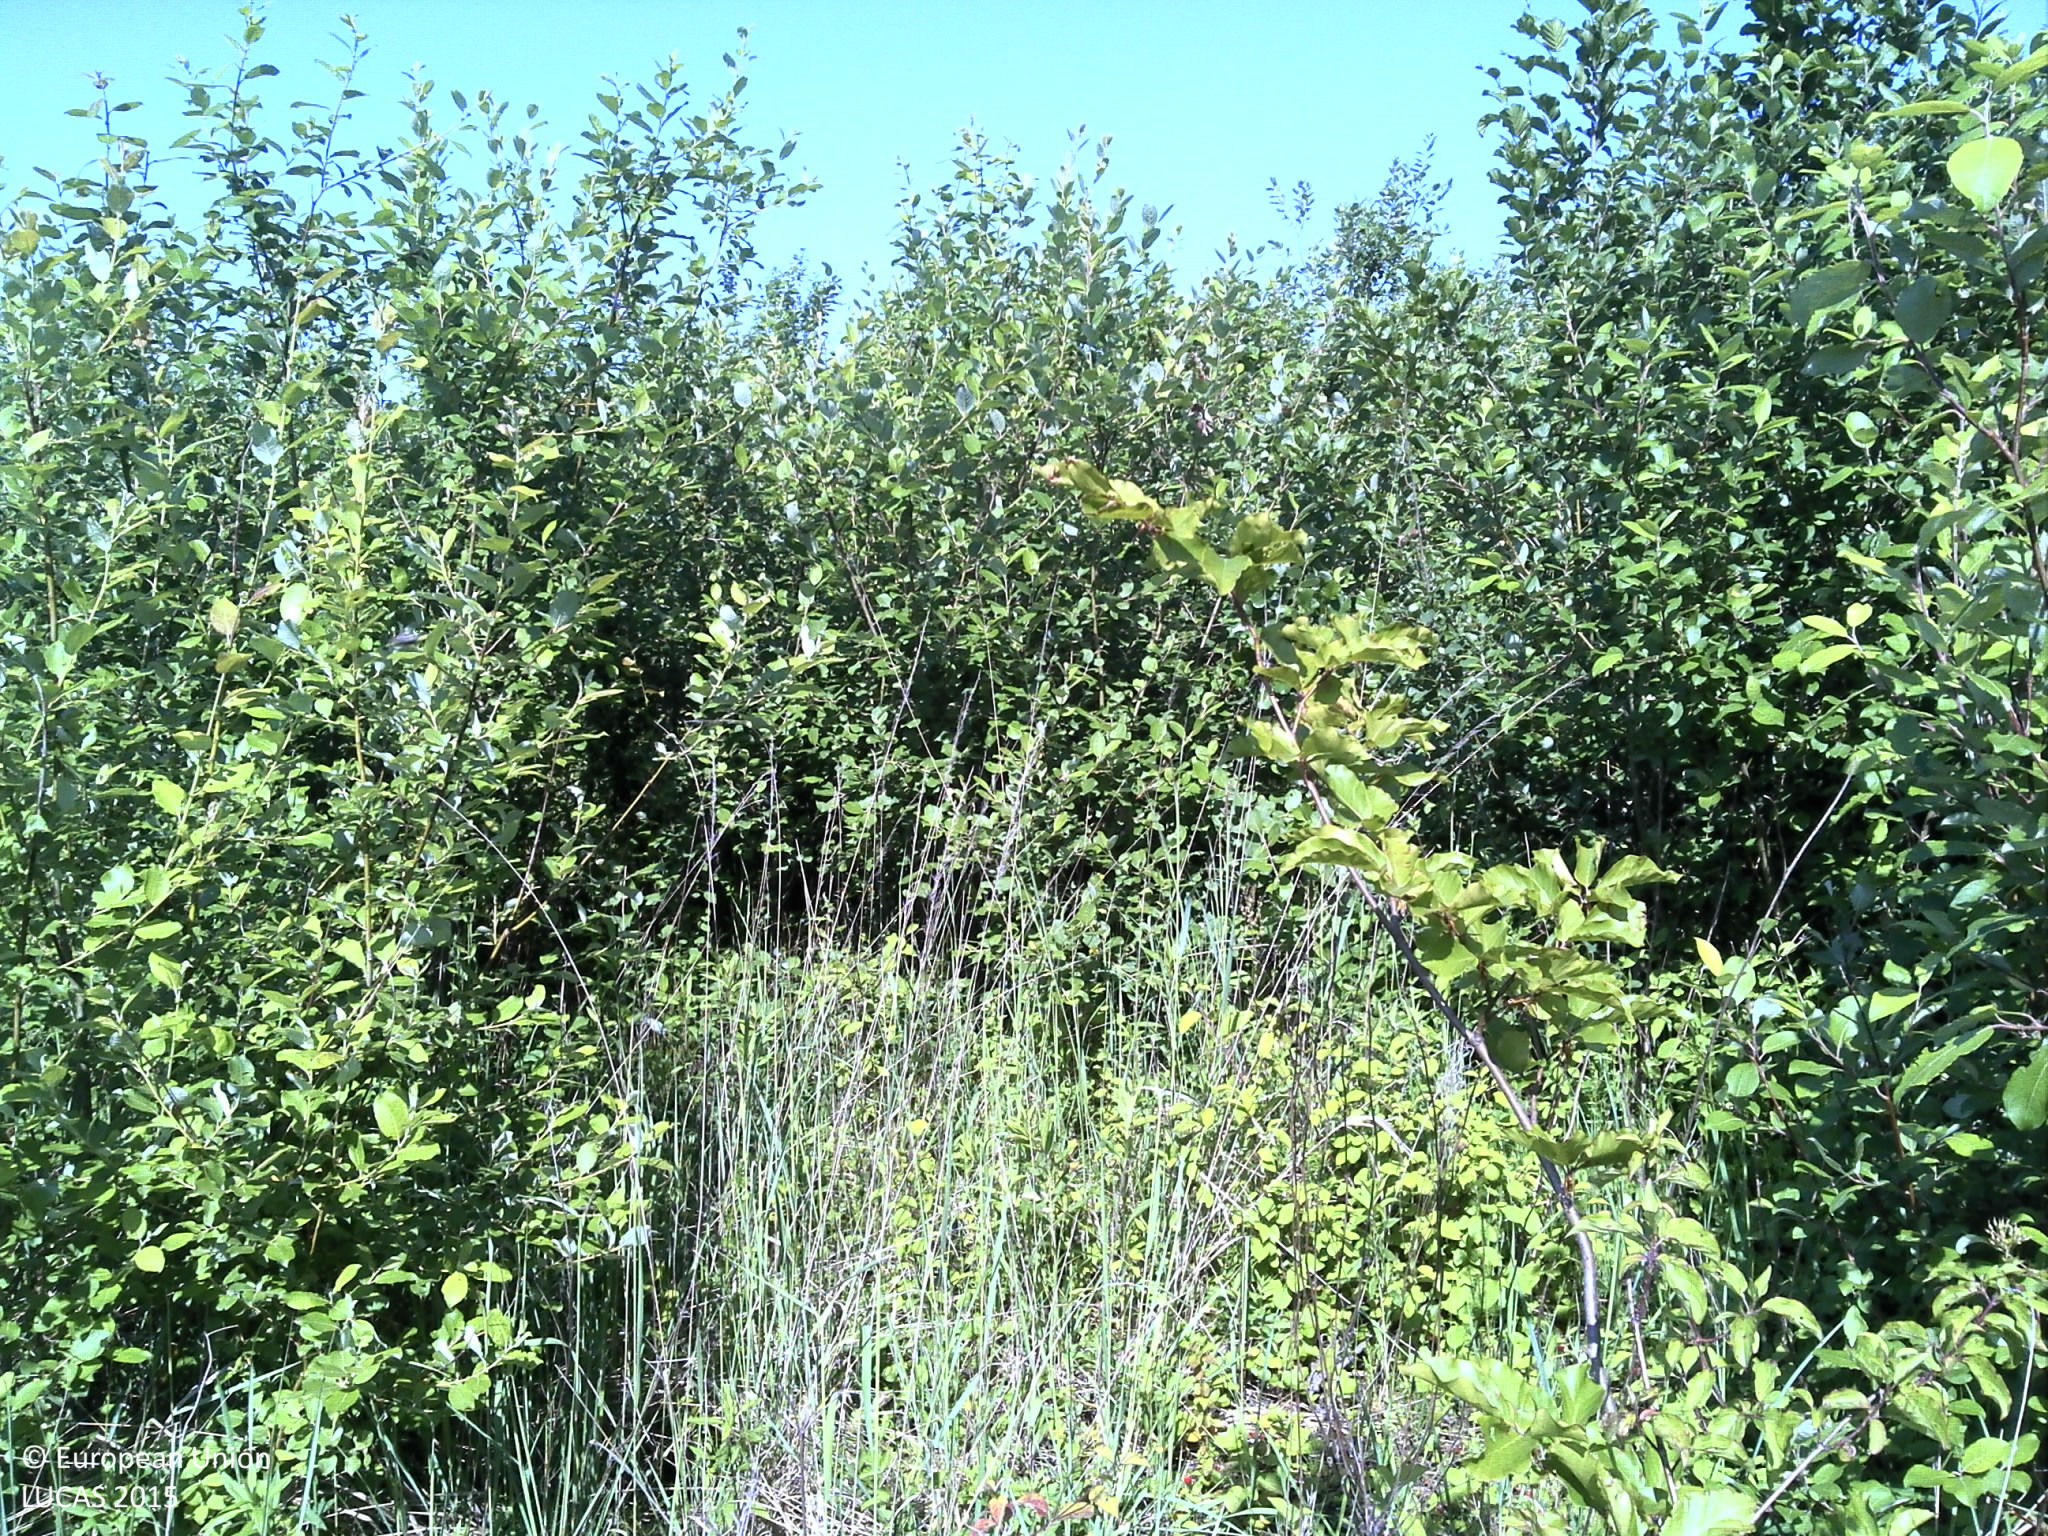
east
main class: Shrubland
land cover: Shrubland with sparse tree cover
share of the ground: > 75 %
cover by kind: shrubs 90 %, broadleaved forest trees 5 %, herbaceous plants 5 %
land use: Semi-natural and natural areas not in use
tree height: < 5 m
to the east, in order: Shrubland with sparse tree cover; Grassland with sparse tree/shrub cover; Shrubland with sparse tree cover; Tracks; Electric lines; Grassland without tree/shrub cover
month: May
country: HR
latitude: 45.3827
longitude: 17.9852
